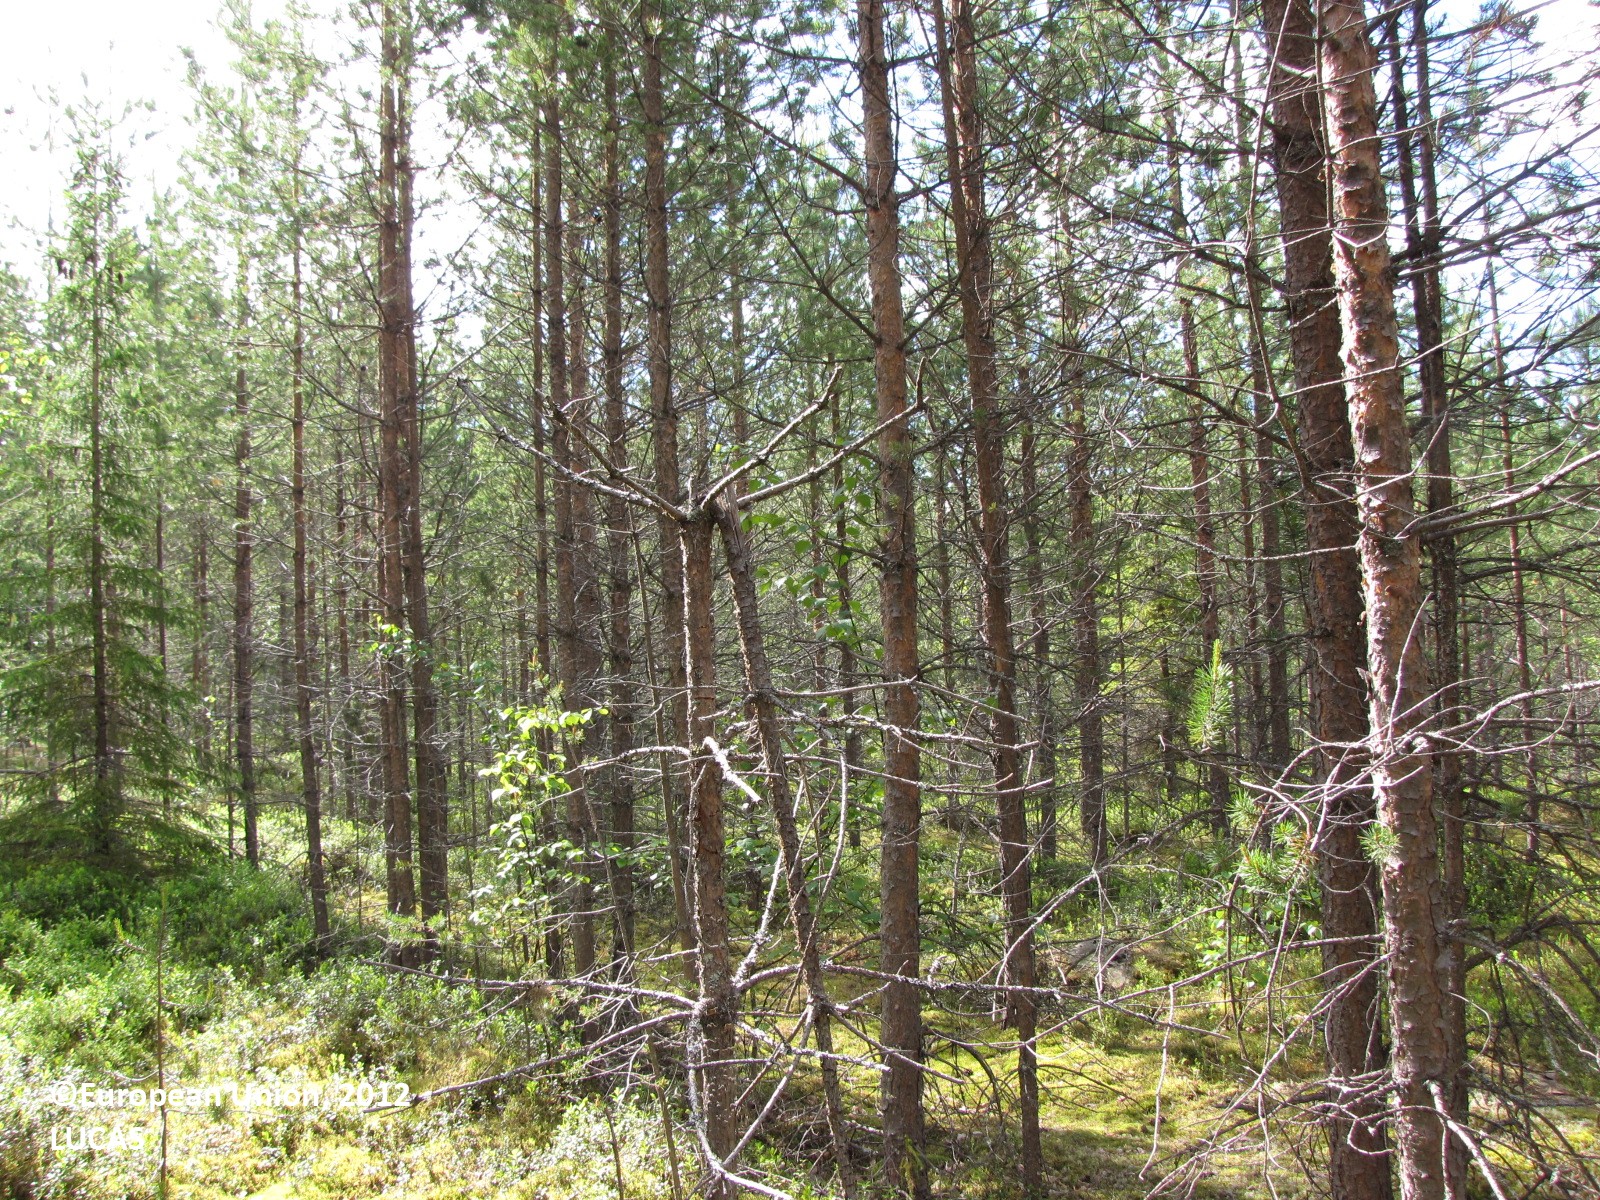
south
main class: Woodland
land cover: Pine dominated coniferous woodland
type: boreal forest
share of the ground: 50 - 75 %
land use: Forestry
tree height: > 5 m
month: July
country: FI
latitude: 66.1342
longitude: 25.2360
